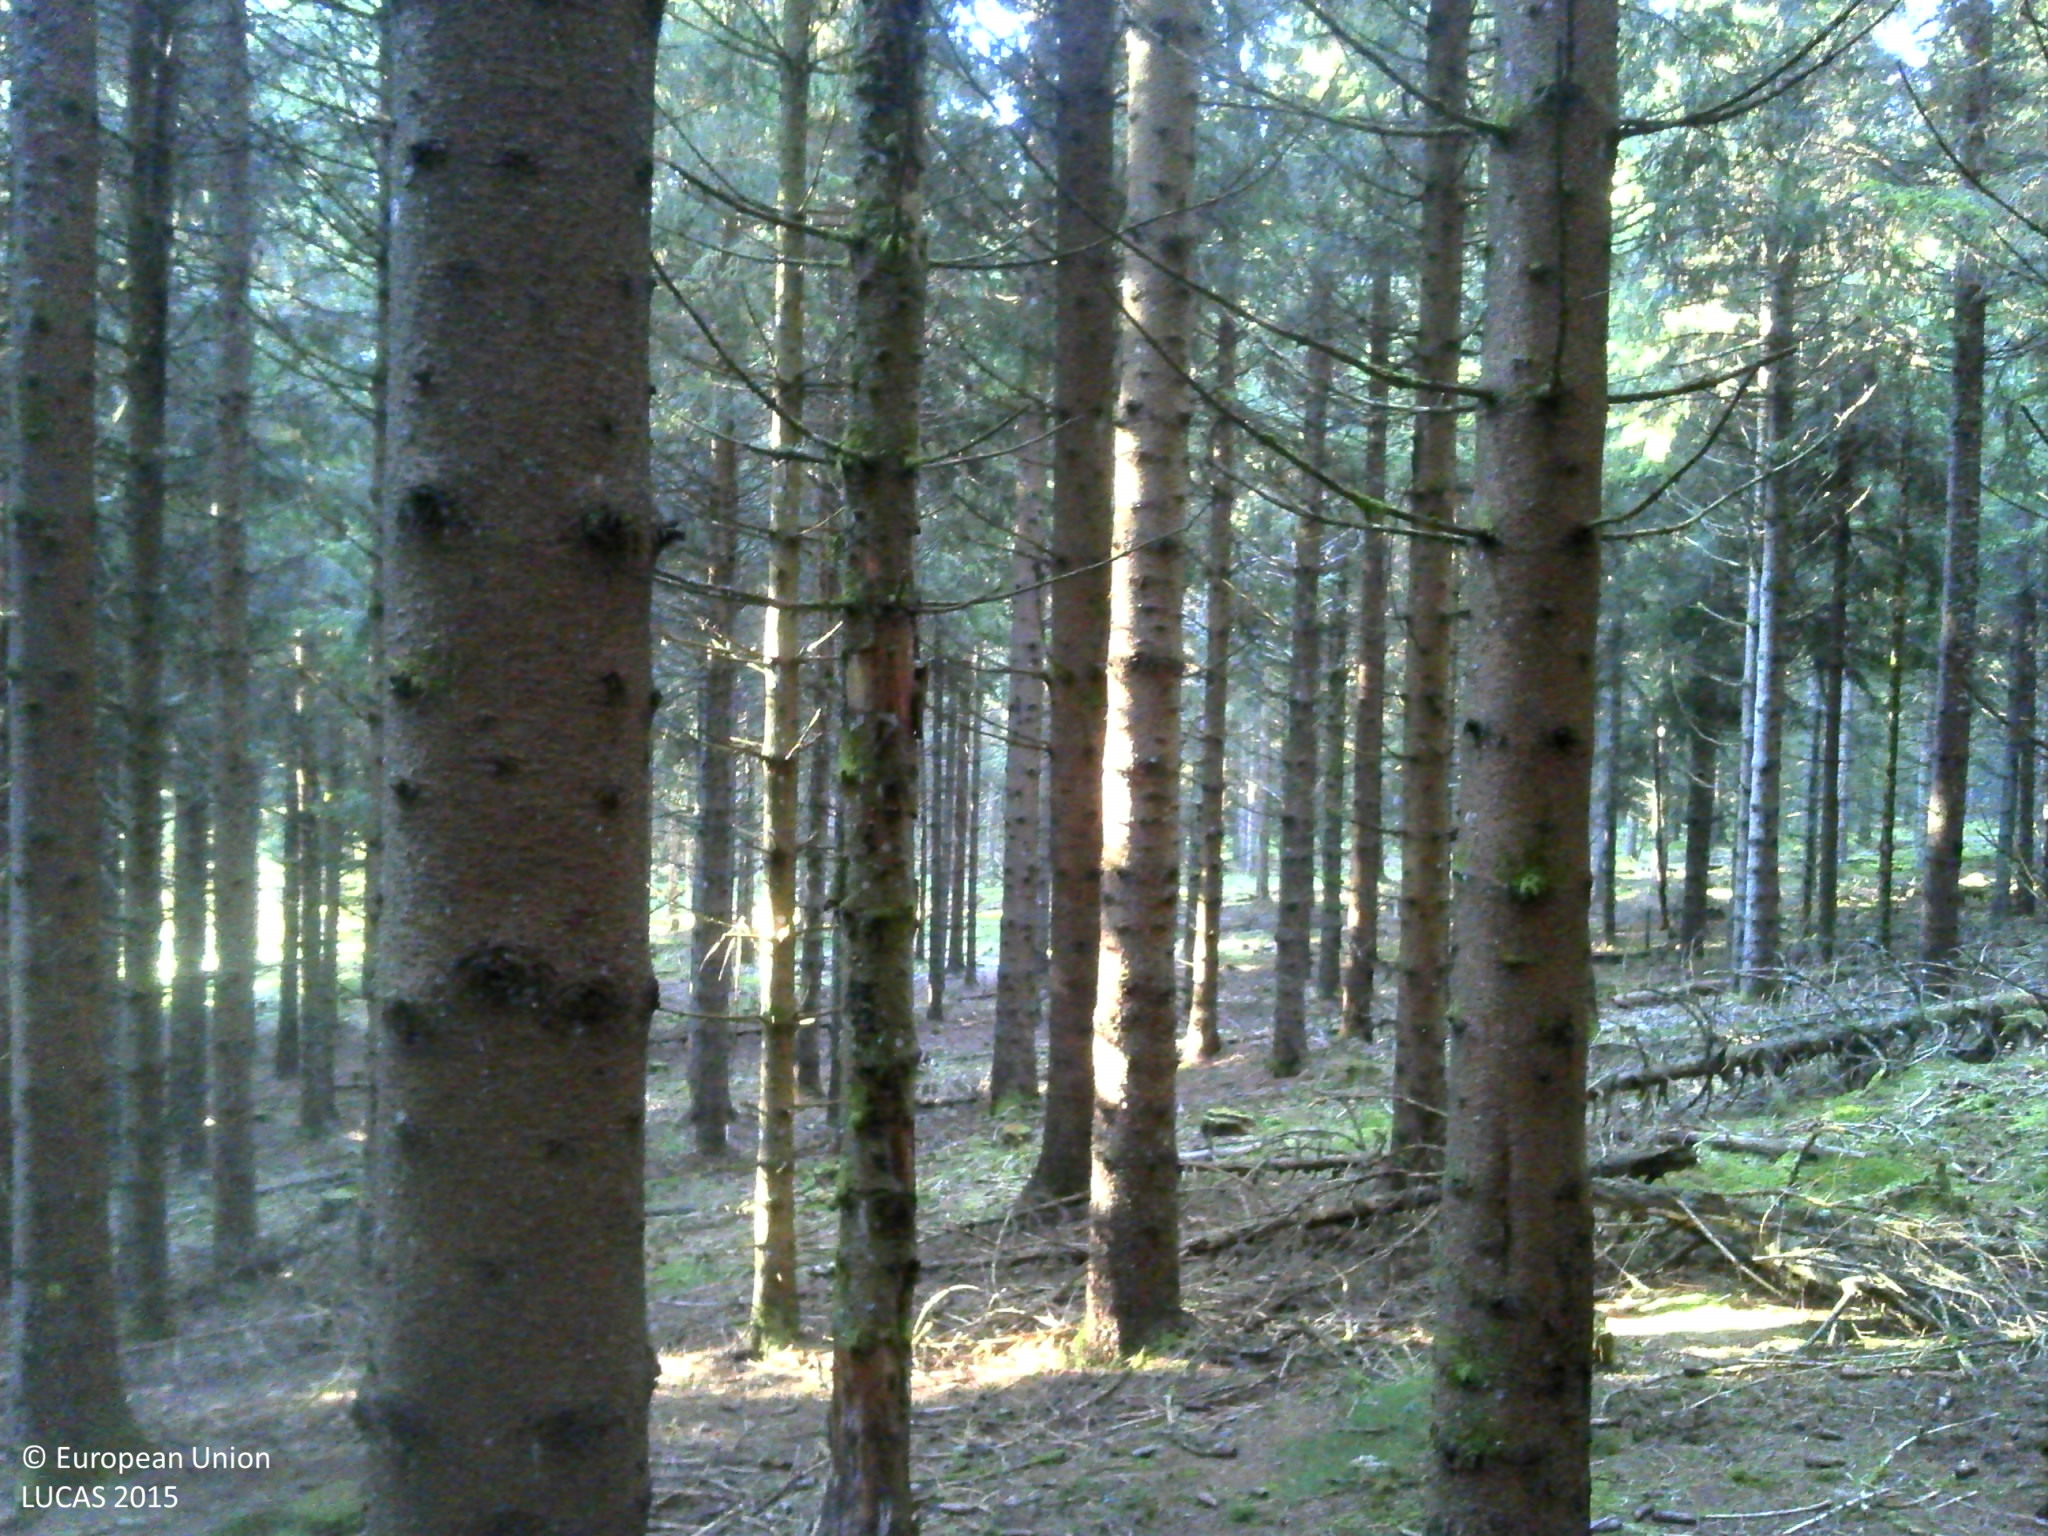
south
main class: Woodland
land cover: Spruce dominated coniferous woodland
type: exotic forest
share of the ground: > 75 %
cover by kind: coniferous forest trees 90 %, lichens and mosses 5 %, unconsolidated bare surface 5 %
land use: Forestry
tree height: > 5 m
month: October
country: FR
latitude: 45.4822
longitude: 2.8996
